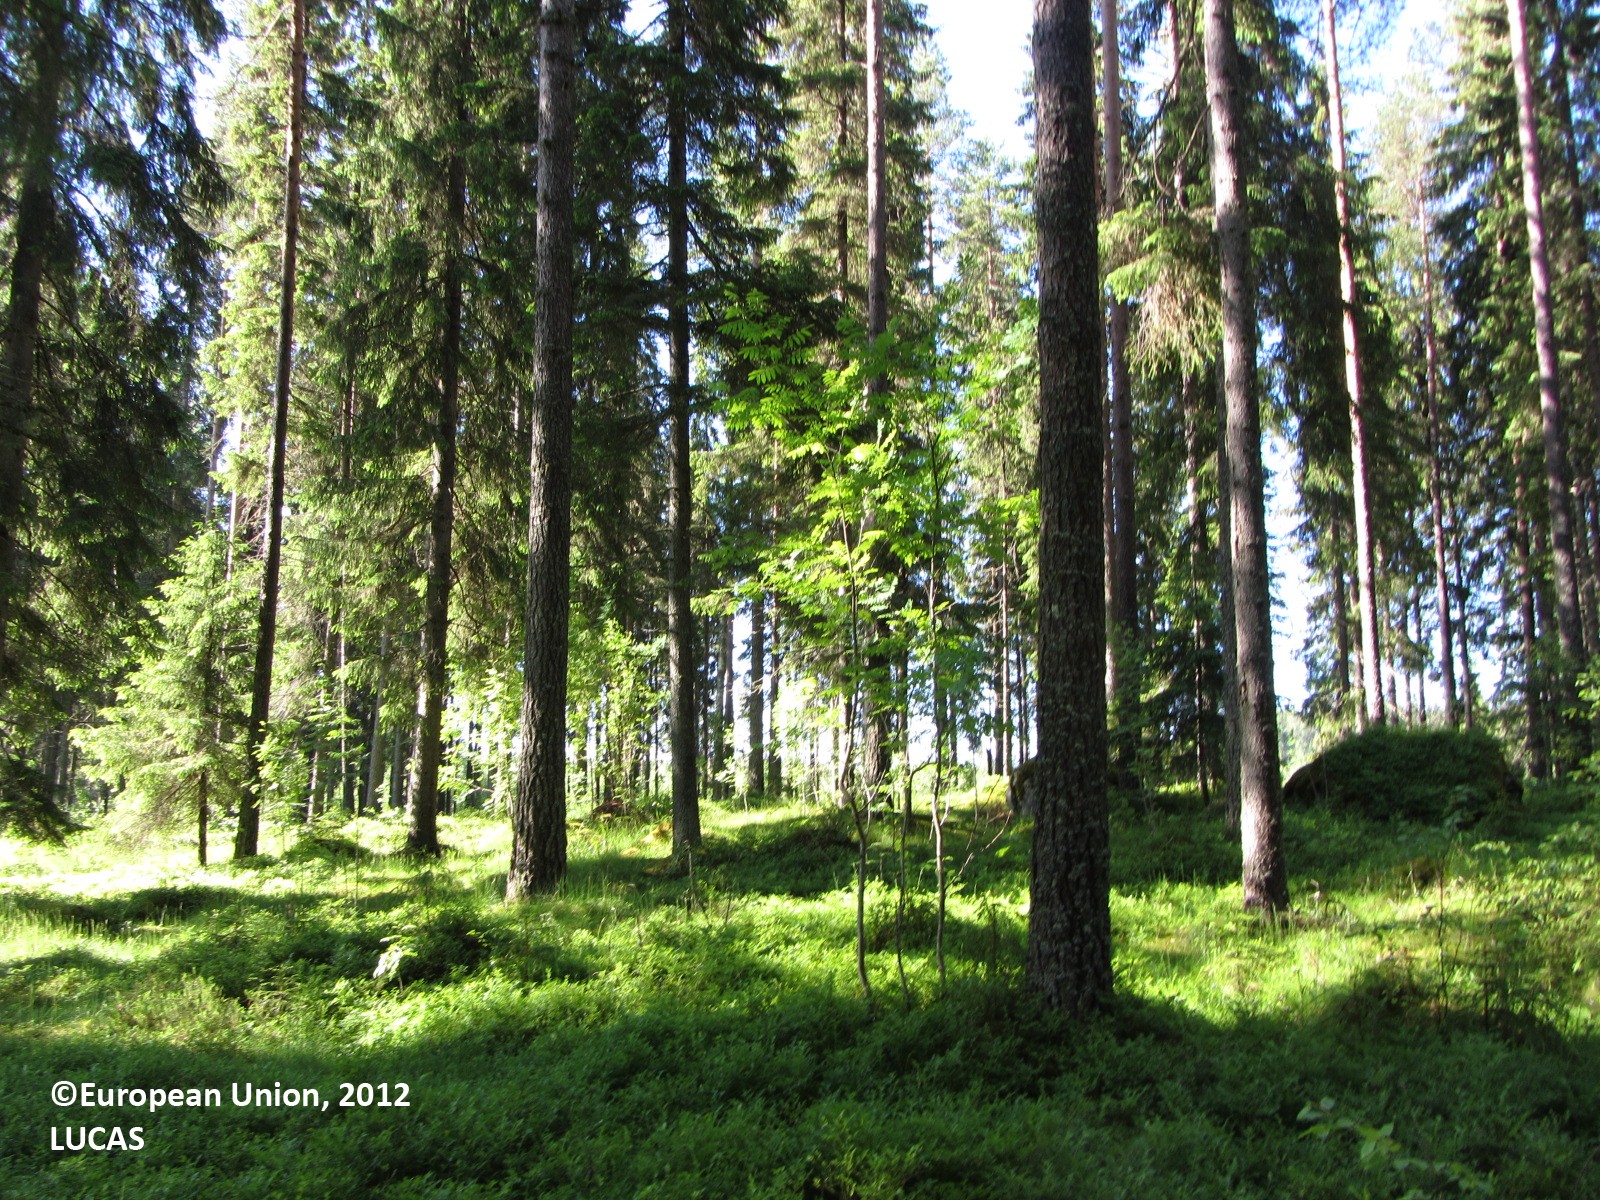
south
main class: Woodland
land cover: Spruce dominated coniferous woodland
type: boreal forest
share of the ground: > 75 %
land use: Forestry
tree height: > 5 m
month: June
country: FI
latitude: 62.1737
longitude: 25.2999
